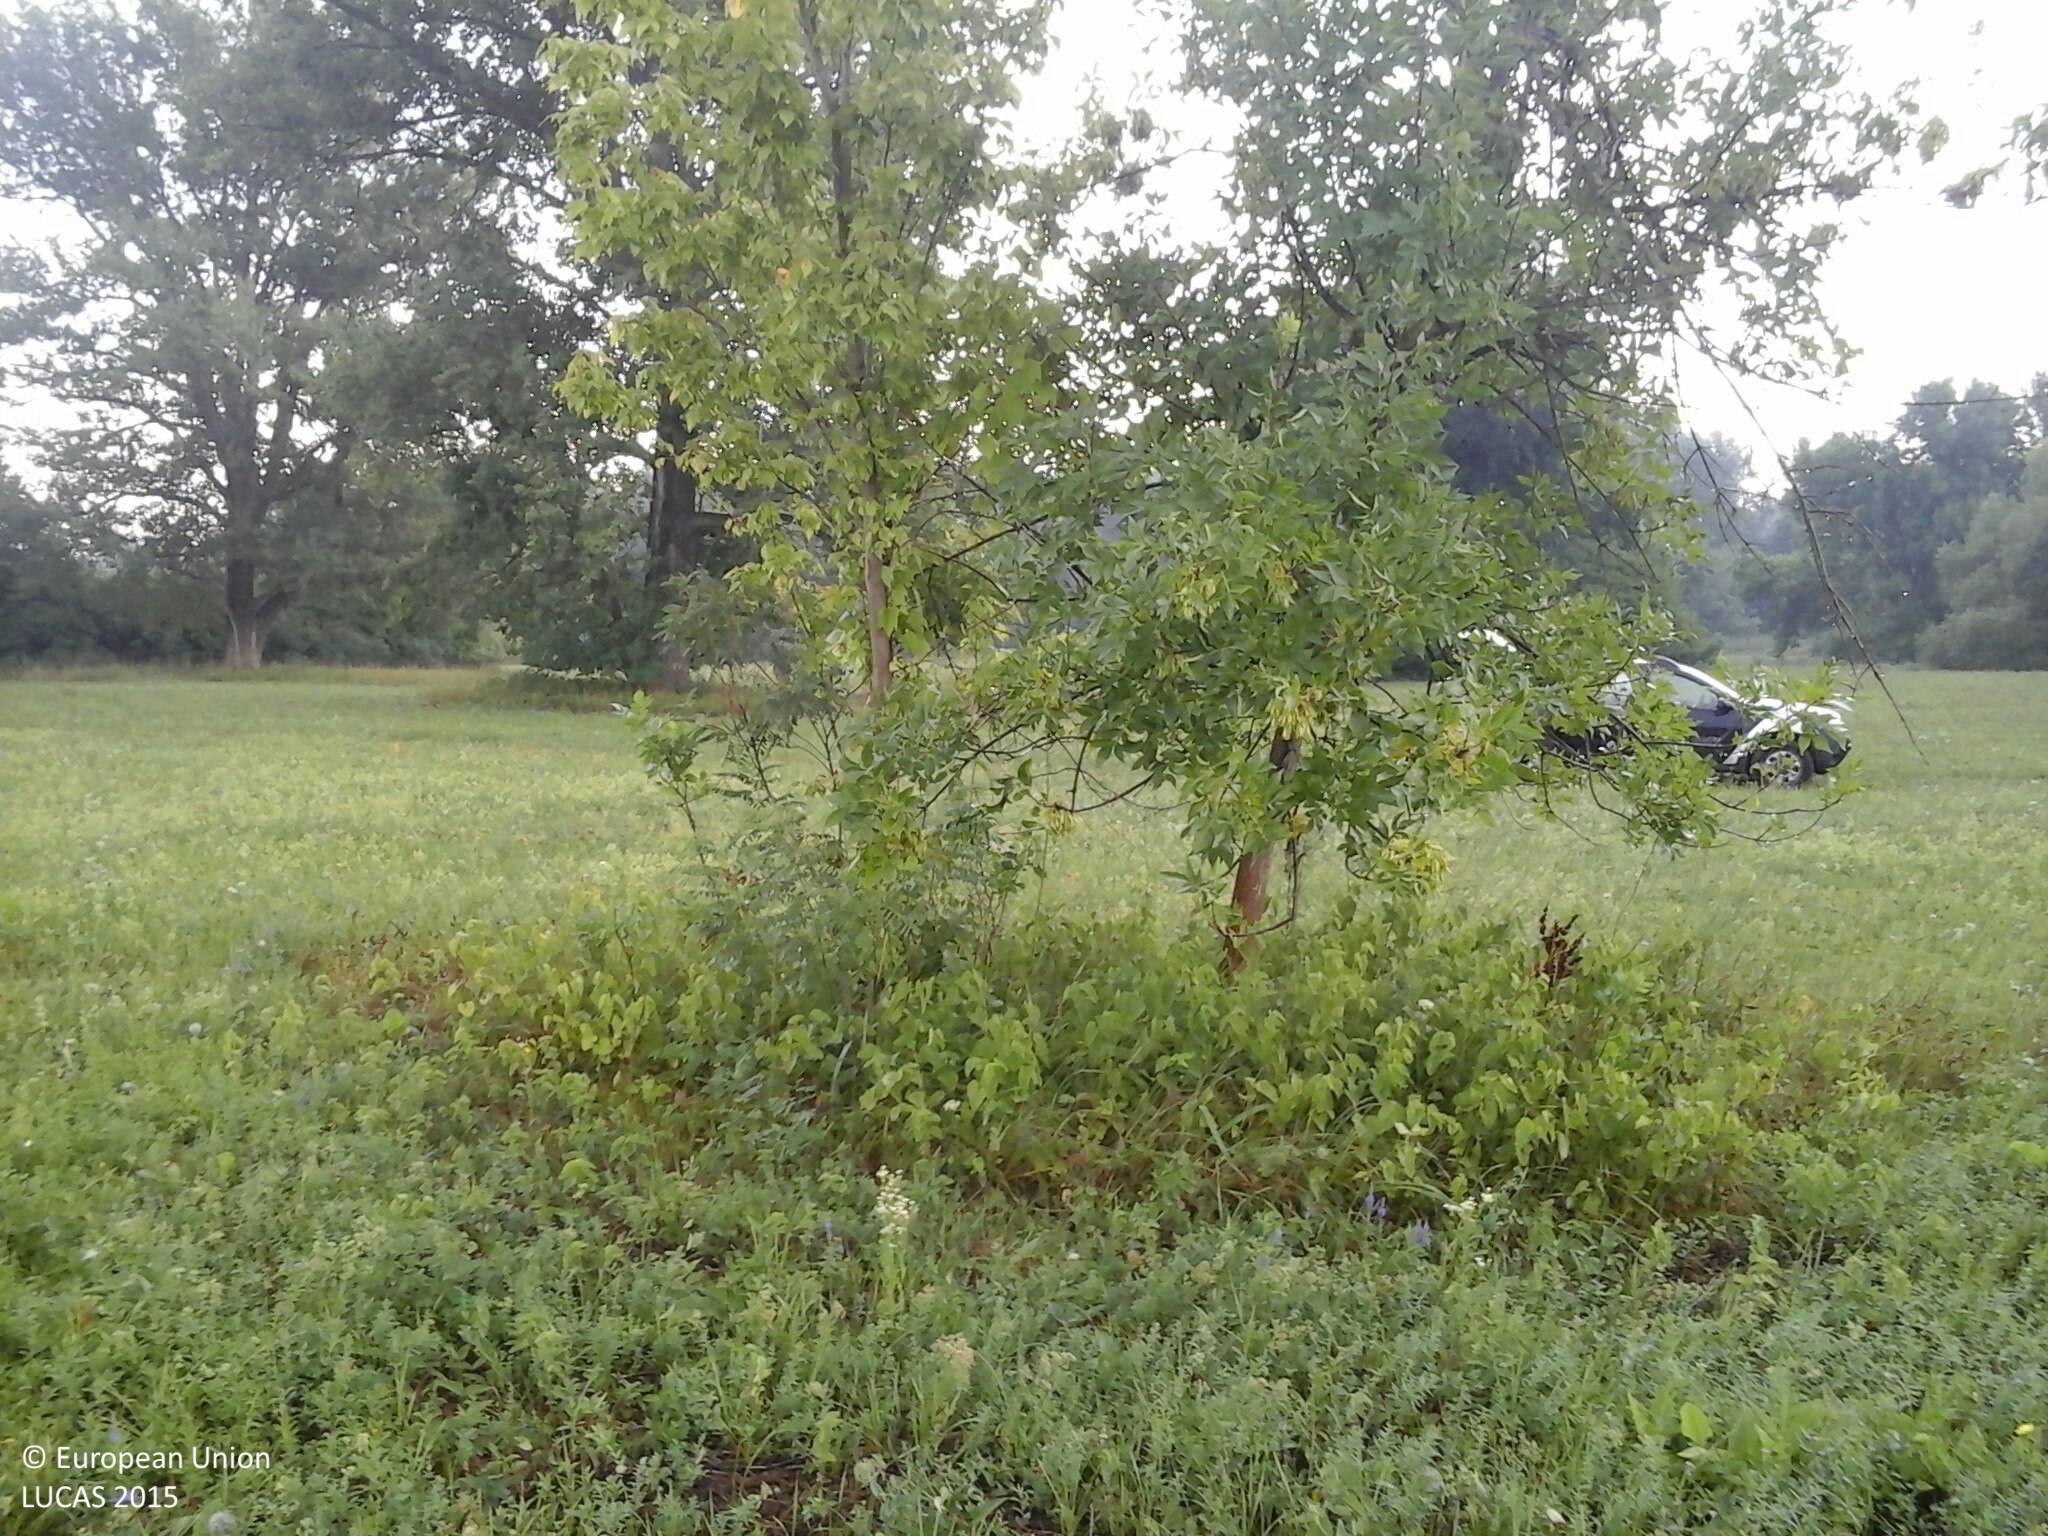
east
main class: Grassland
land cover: Grassland with sparse tree/shrub cover
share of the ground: > 75 %
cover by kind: herbaceous plants 85 %, shrubs 10 %, broadleaved forest trees 5 %
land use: Agriculture (excluding fallow land and kitchen gardens)
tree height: > 5 m
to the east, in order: Grassland with sparse tree/shrub cover
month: August
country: HU
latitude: 47.9353
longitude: 21.0829
